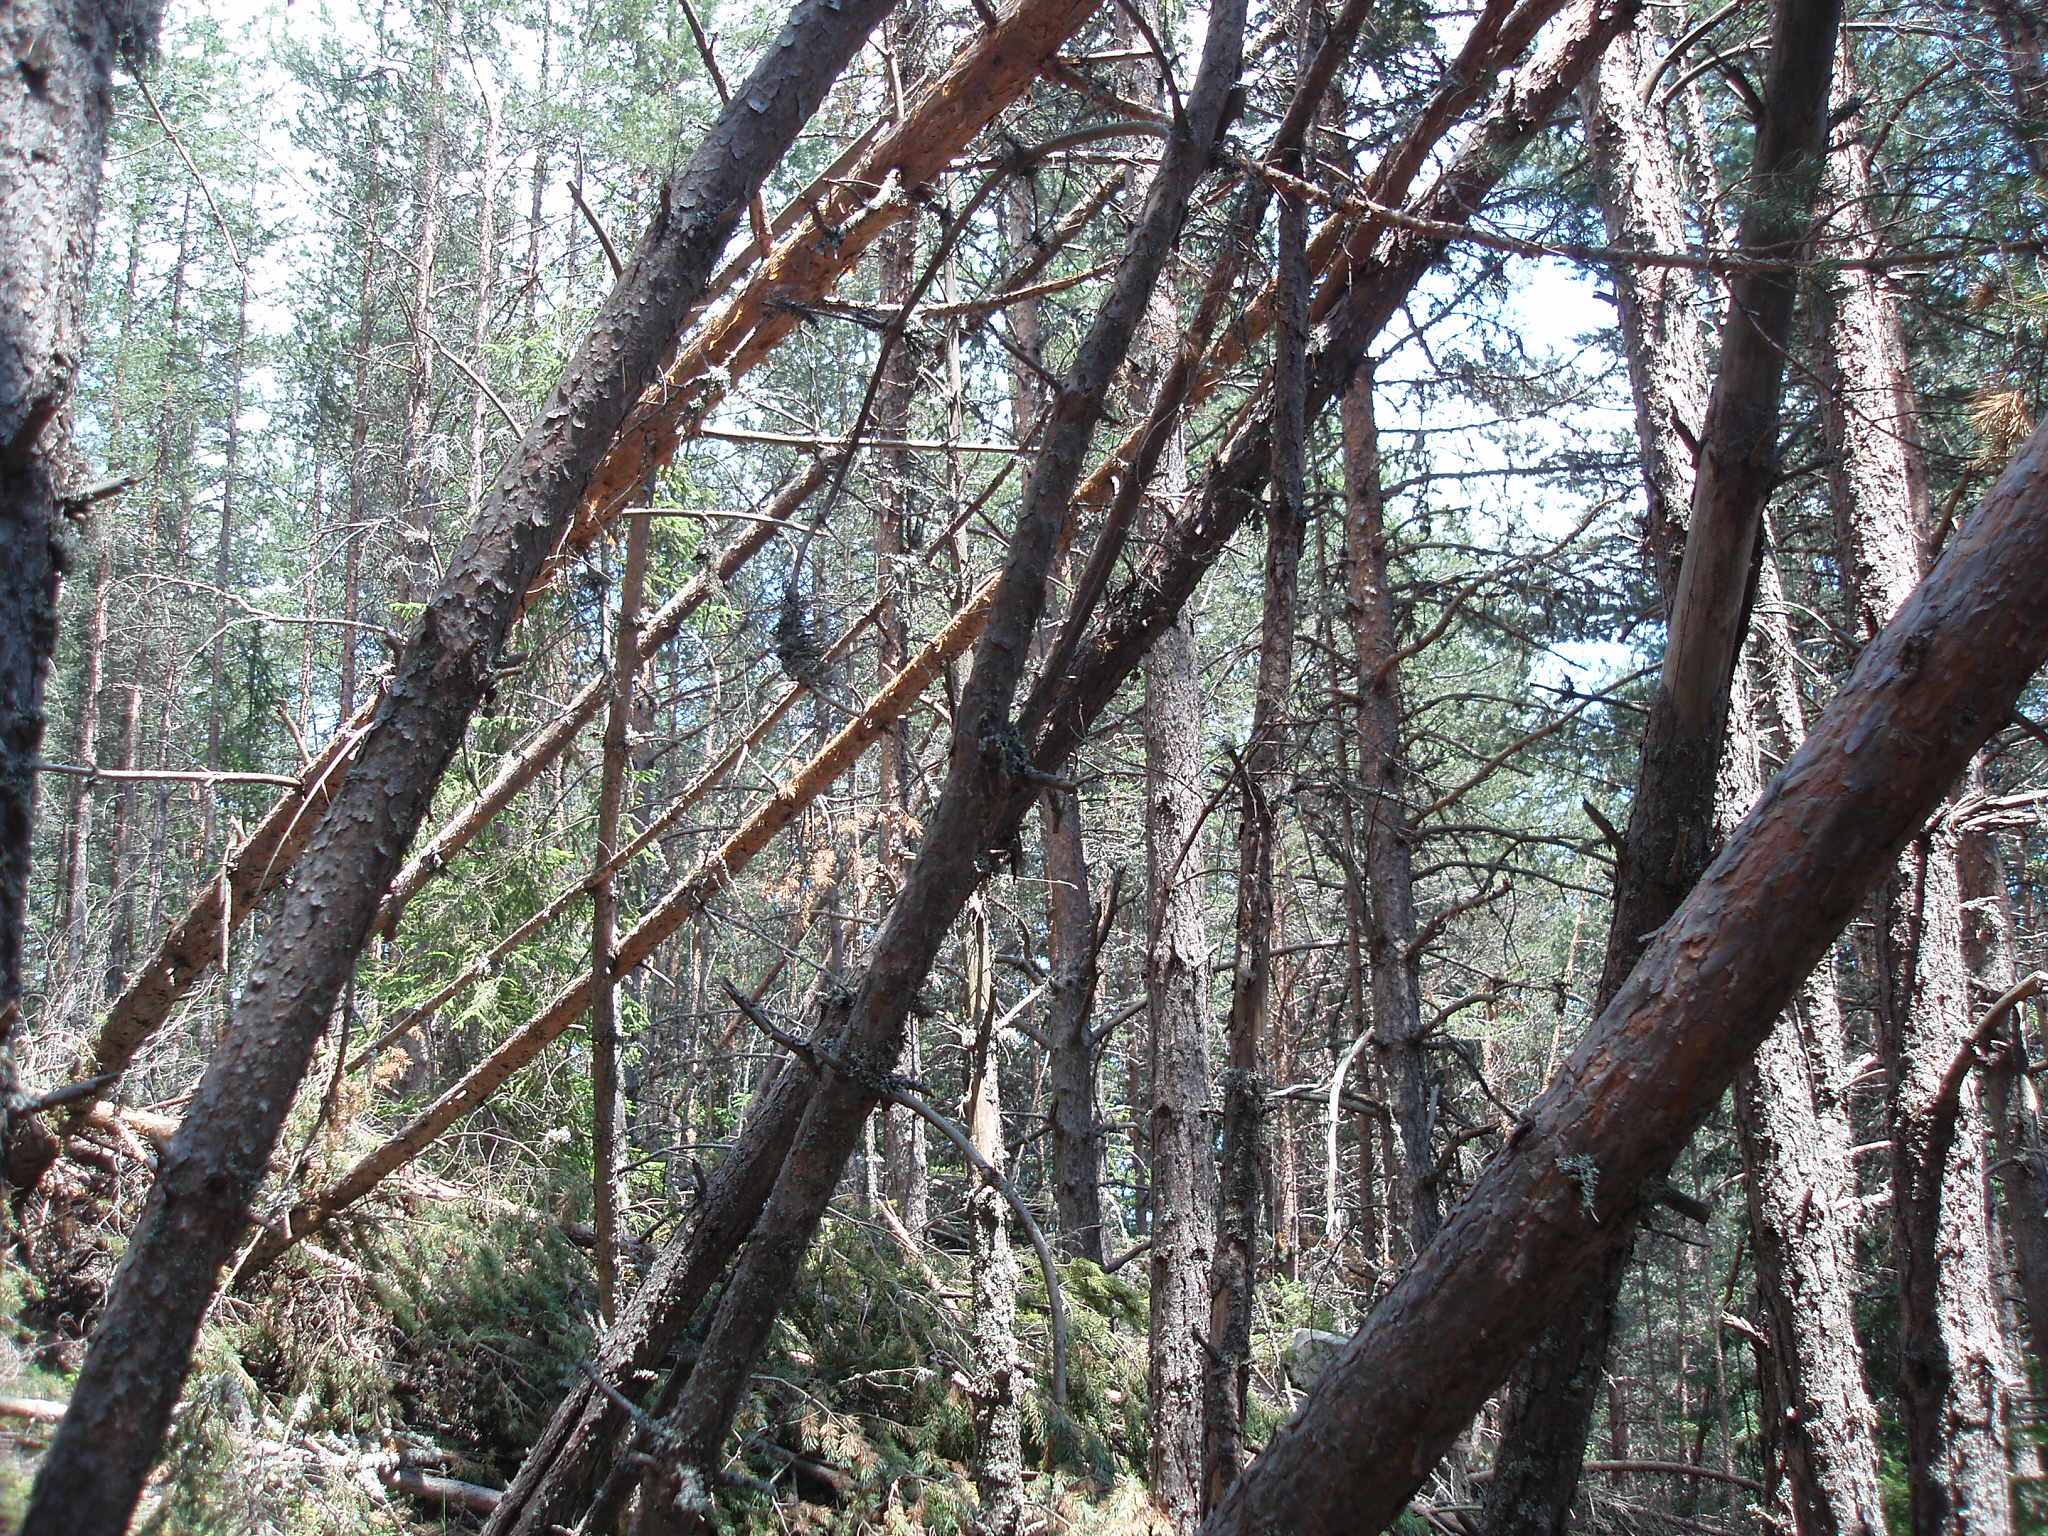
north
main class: Woodland
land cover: Spruce dominated coniferous woodland
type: hemiboreal forest and nemoral coniferous forest and mixed broadleaved-coniferous forest
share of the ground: > 75 %
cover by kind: coniferous forest trees 95 %, unconsolidated bare surface 5 %
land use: Forestry
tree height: > 5 m
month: July
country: BG
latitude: 41.9992
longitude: 23.7846
